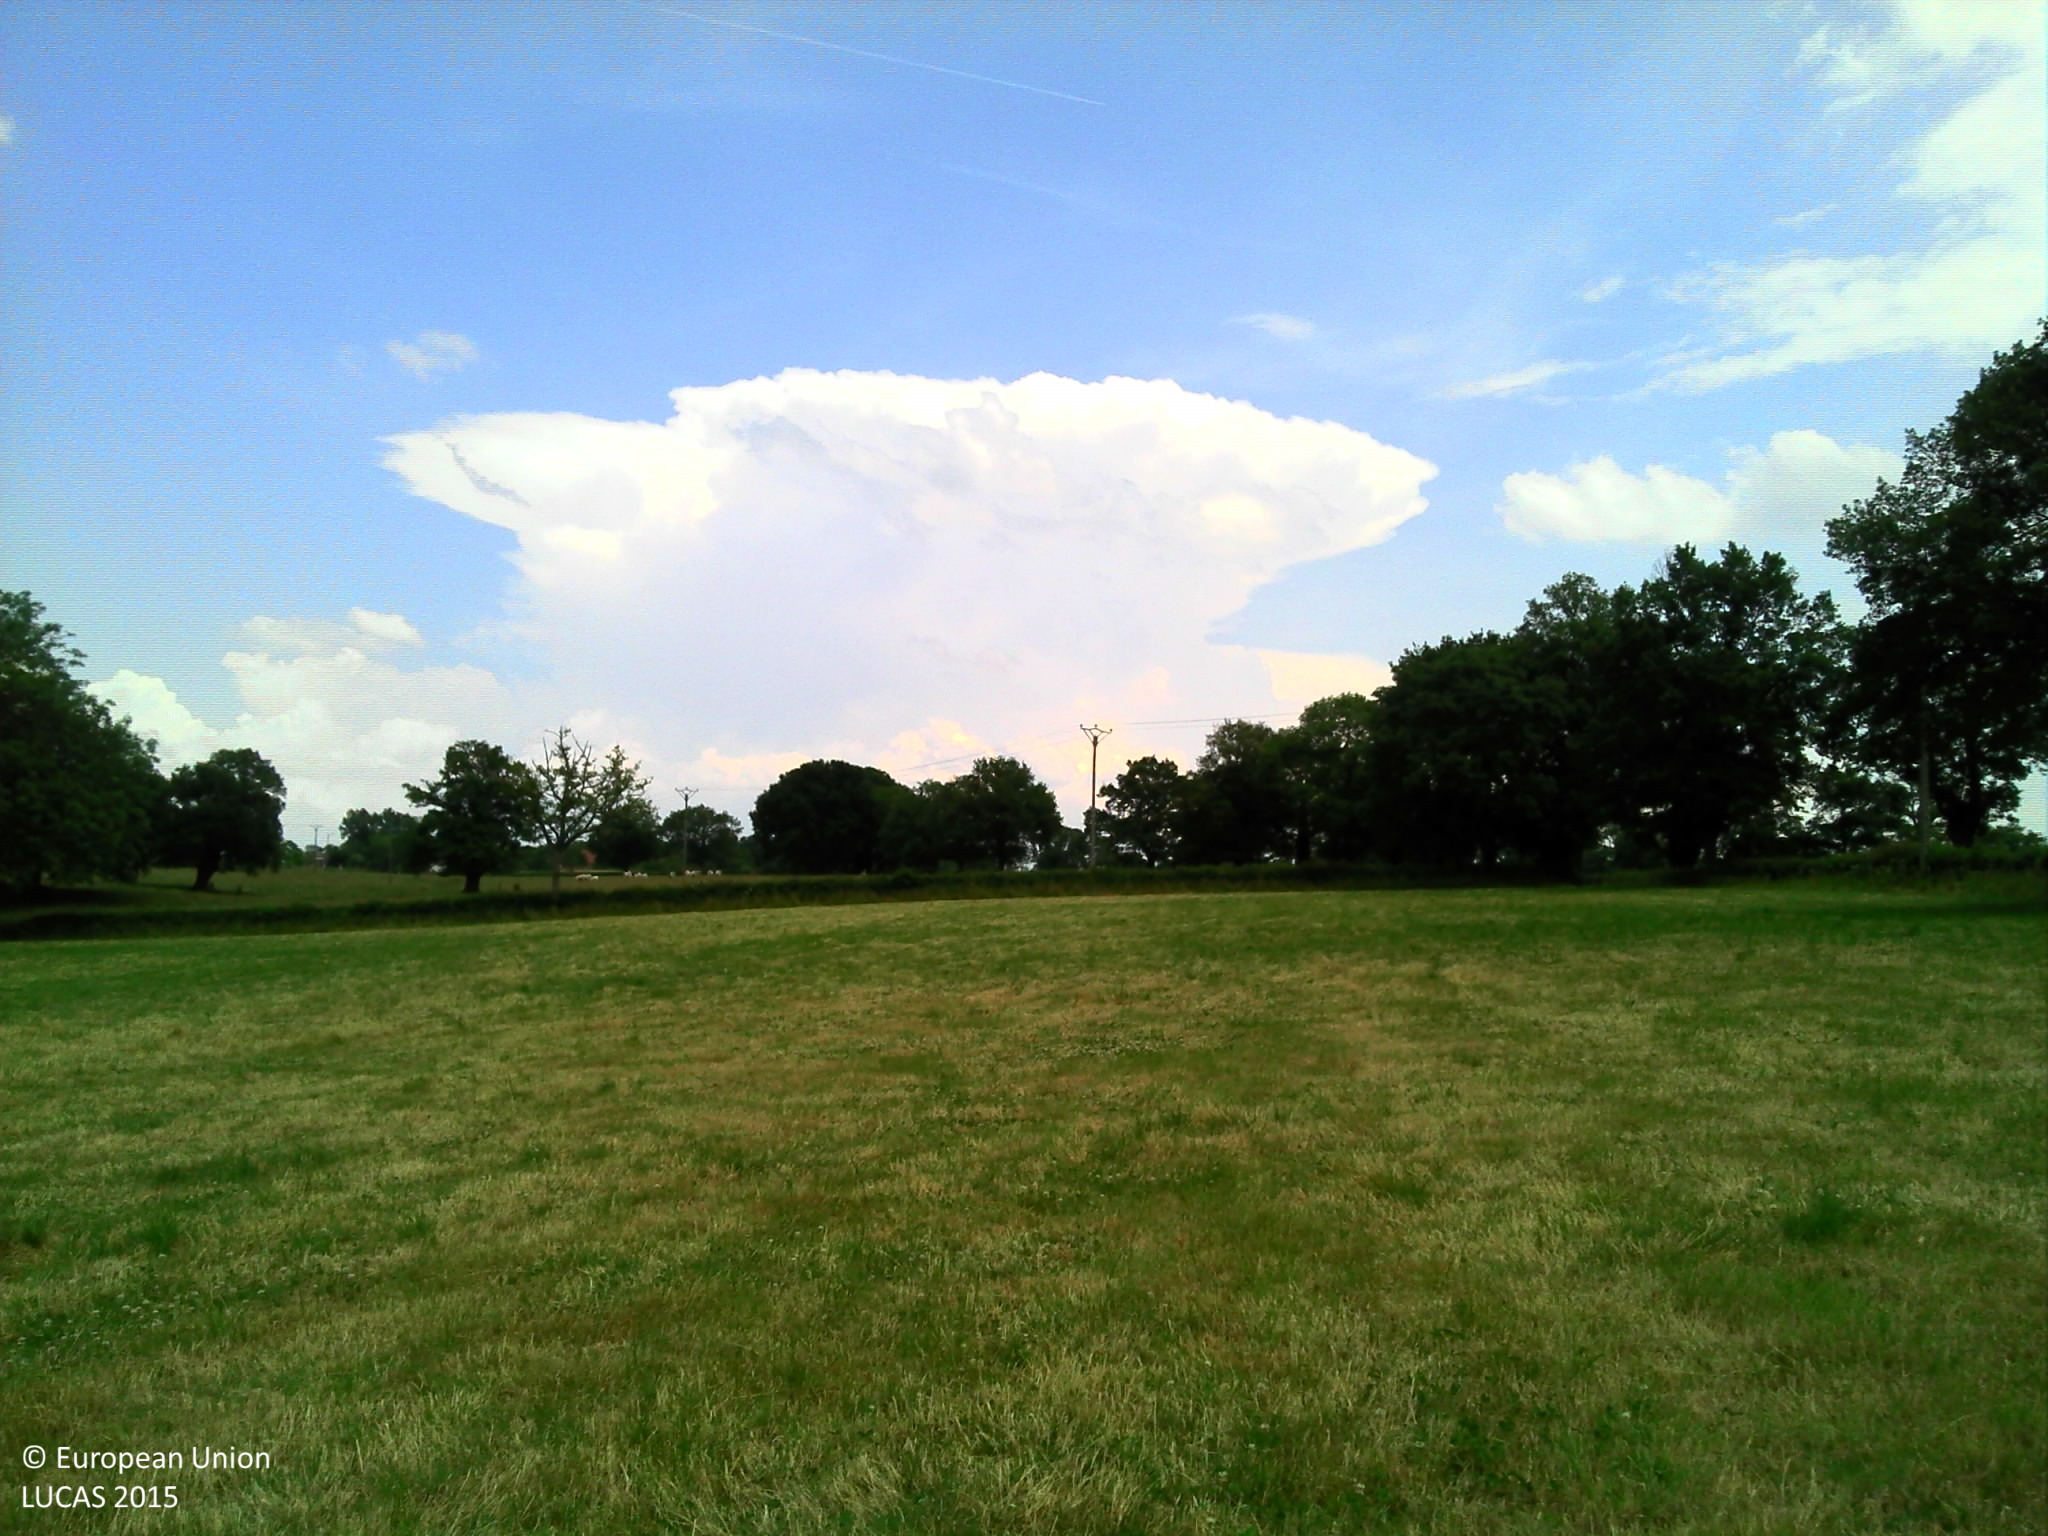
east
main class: Cropland
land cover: Temporary grasslands
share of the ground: > 75 %
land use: Agriculture (excluding fallow land and kitchen gardens)
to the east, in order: Temporary grasslands; Fences; Managed hedges; Fences; Grassland with sparse tree/shrub cover; Electric lines; Grassland with sparse tree/shrub cover
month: June
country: FR
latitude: 46.3204
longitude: 2.9974
